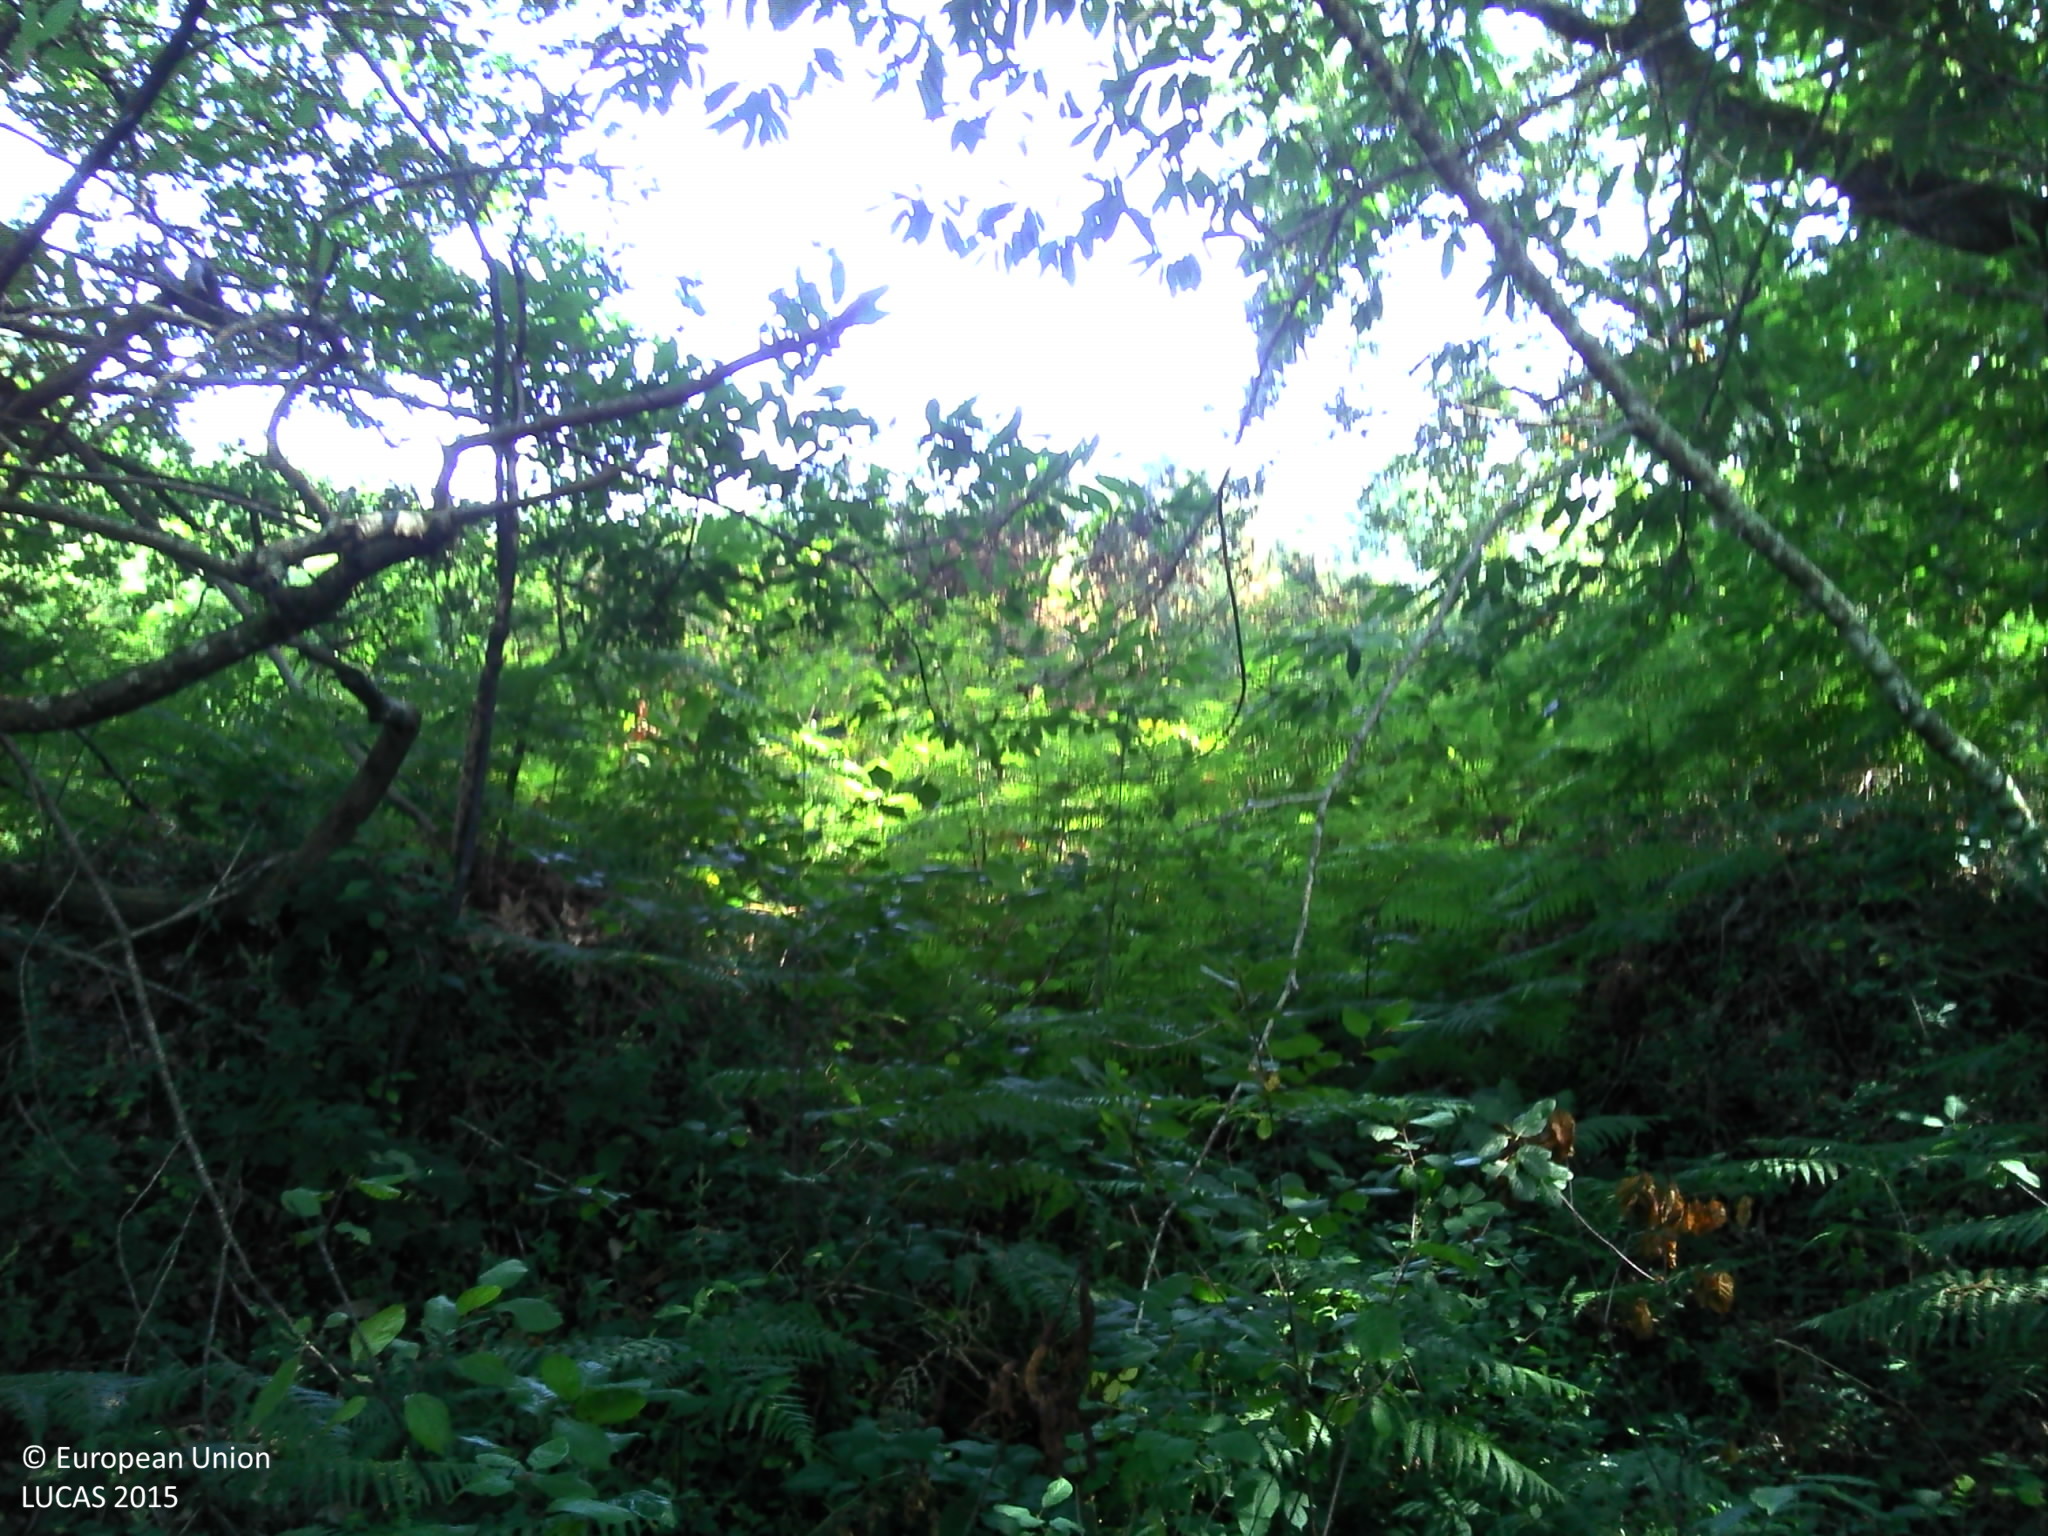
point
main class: Shrubland
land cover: Shrubland with sparse tree cover
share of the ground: > 75 %
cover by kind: shrubs 75 %, herbaceous plants 20 %, broadleaved forest trees 5 %
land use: Forestry
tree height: > 5 m
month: August
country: FR
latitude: 43.7152
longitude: -0.7740
